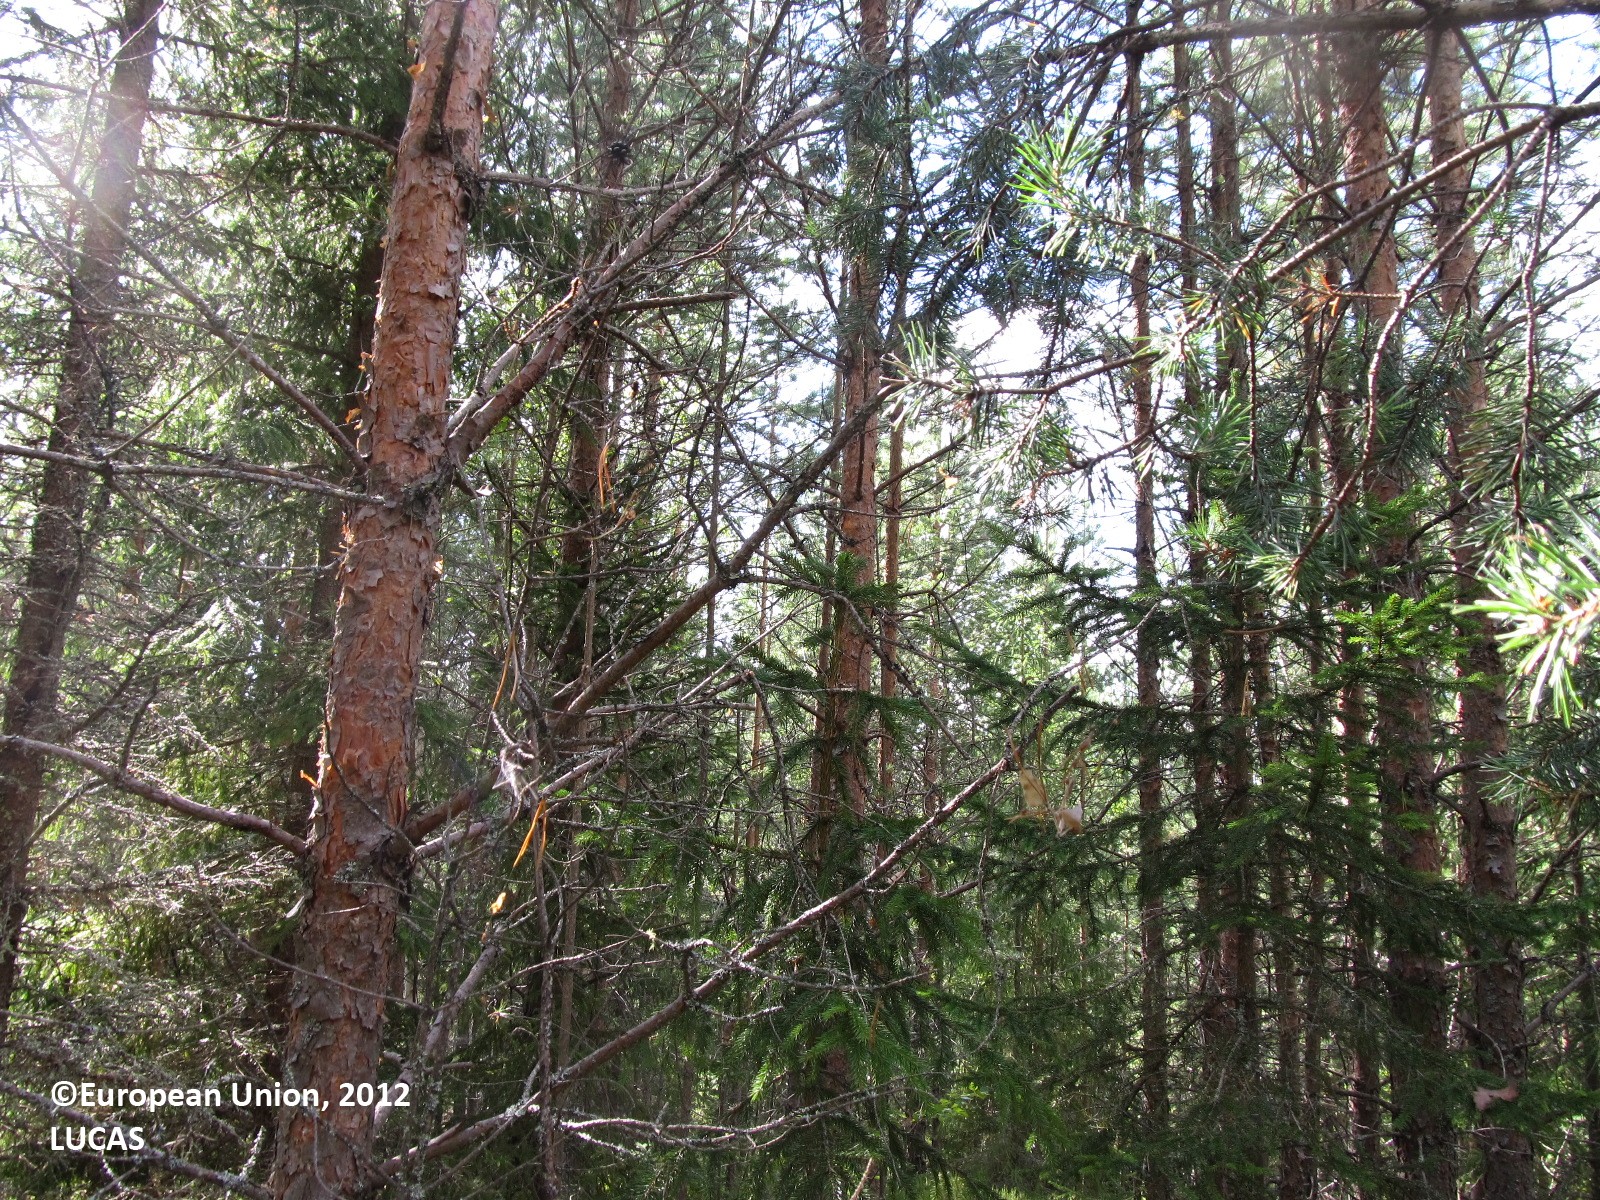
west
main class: Woodland
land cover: Other coniferous woodland
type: boreal forest
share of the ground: 50 - 75 %
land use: Forestry
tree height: > 5 m
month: August
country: FI
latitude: 62.3929
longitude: 27.6399
